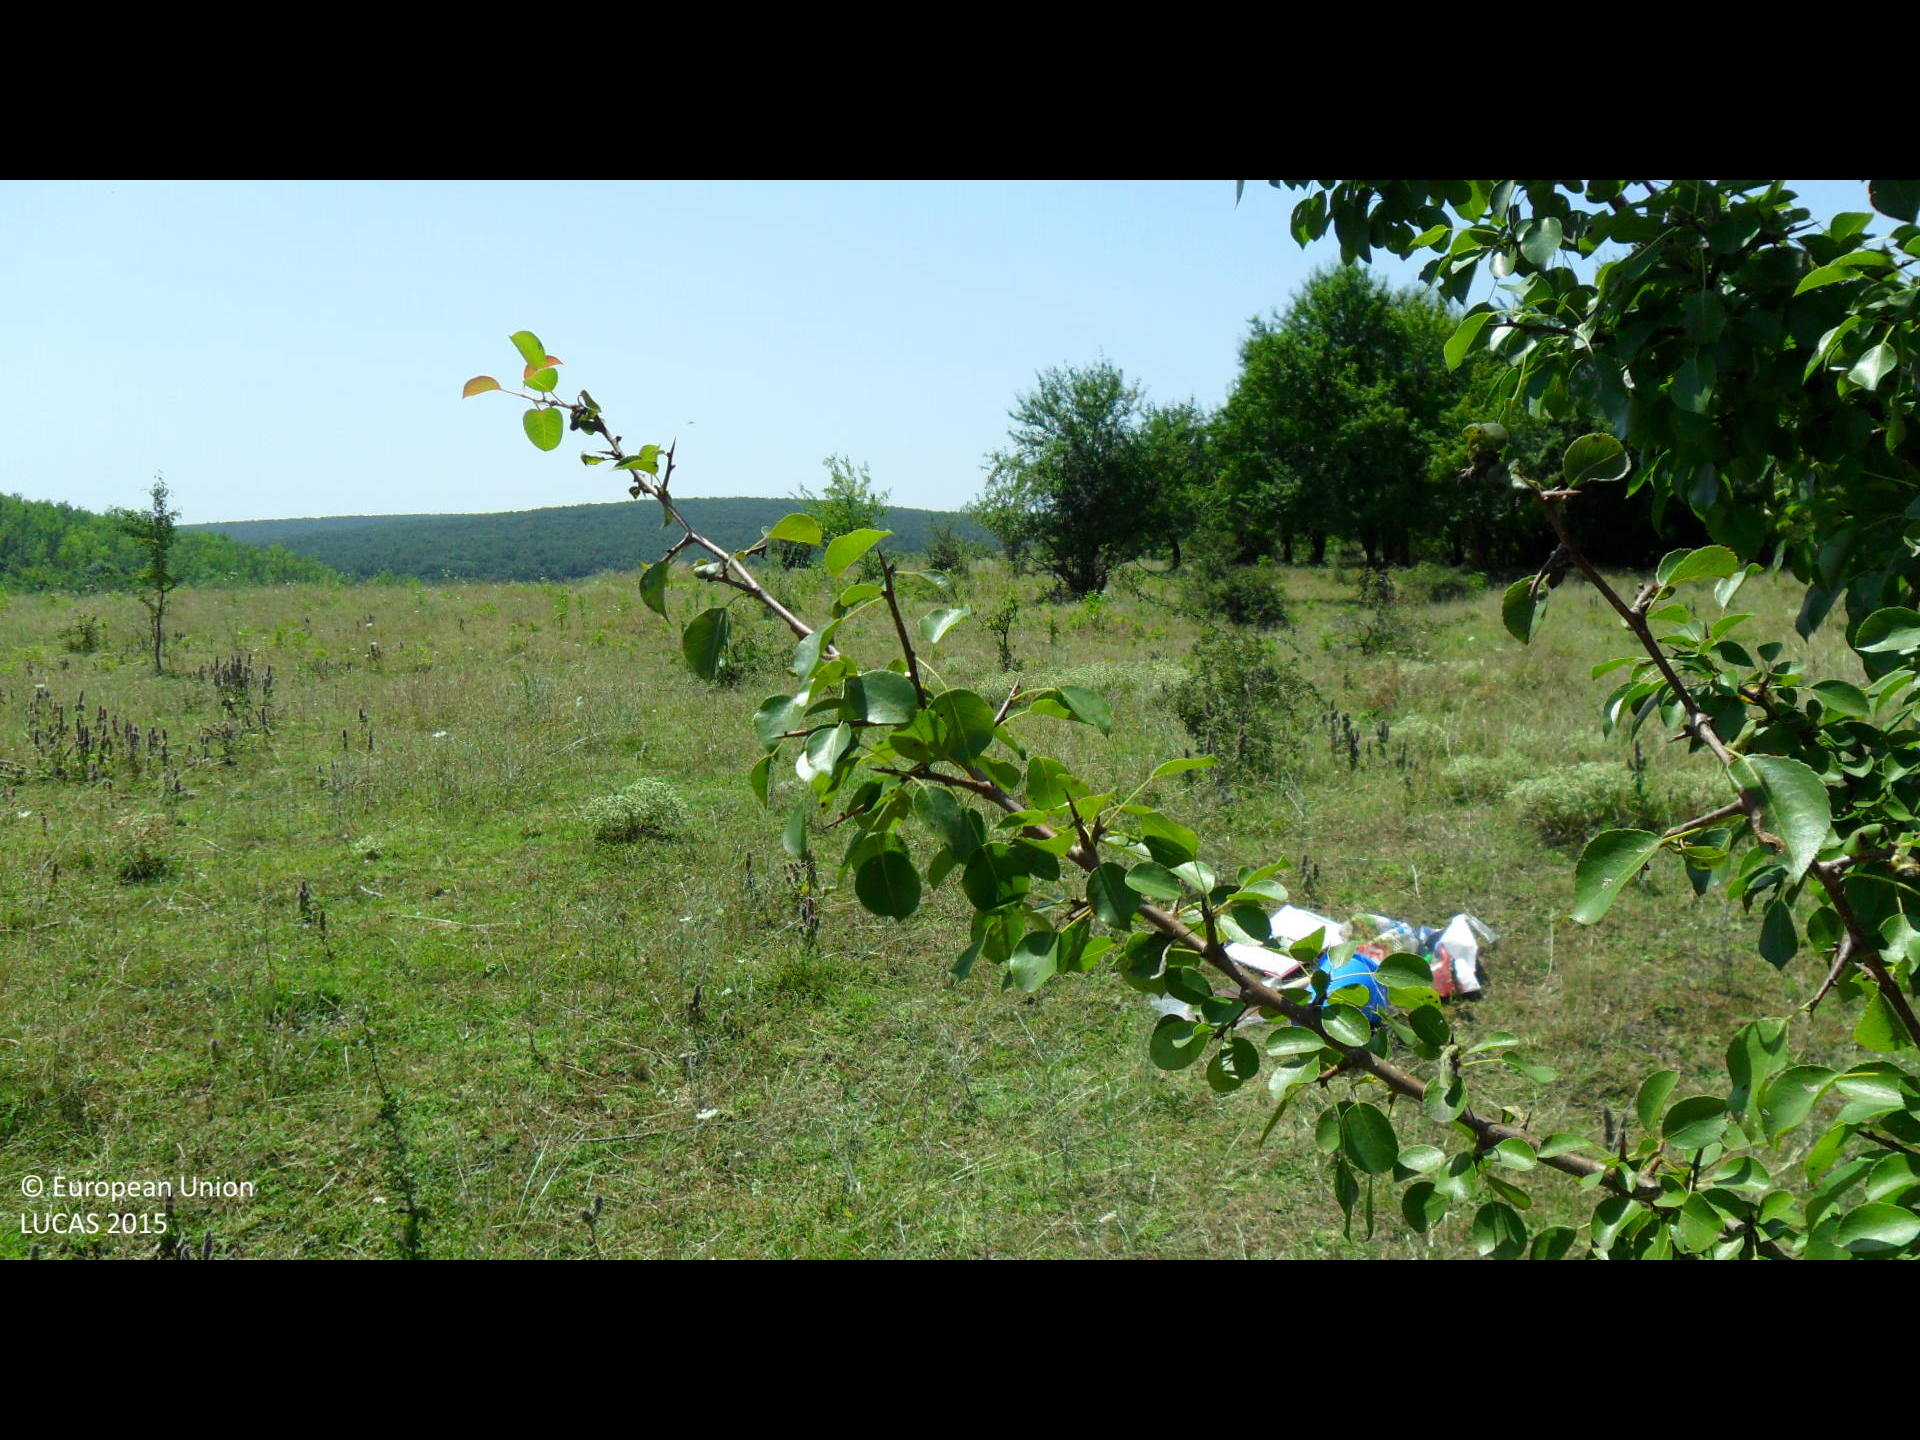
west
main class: Grassland
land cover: Grassland with sparse tree/shrub cover
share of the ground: > 75 %
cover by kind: herbaceous plants 90 %, broadleaved forest trees 5 %, shrubs 5 %
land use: Agriculture (excluding fallow land and kitchen gardens)
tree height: > 5 m
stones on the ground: < 10 %
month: August
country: BG
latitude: 43.3204
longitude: 26.1112
